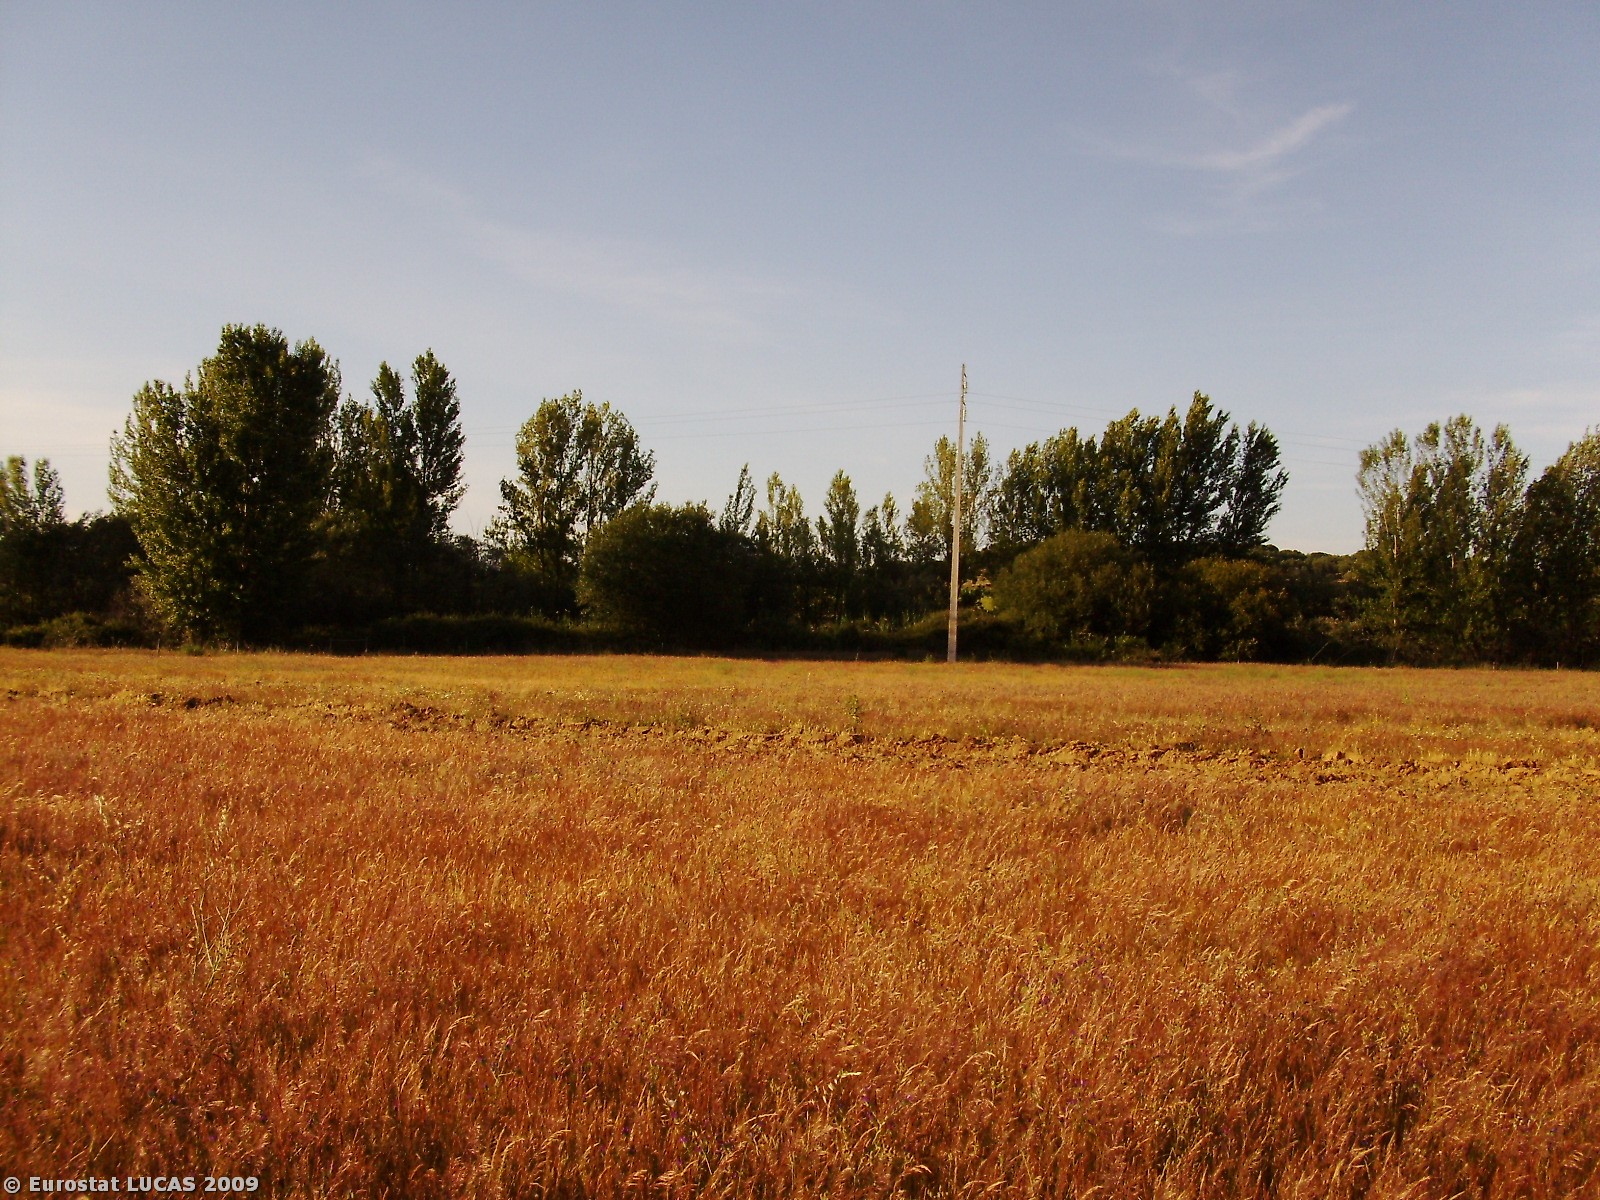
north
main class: Grassland
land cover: Grassland without tree/shrub cover
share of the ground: > 75 %
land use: Agriculture (excluding fallow land and kitchen gardens)
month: May
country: PT
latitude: 39.0984
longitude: -8.0326
